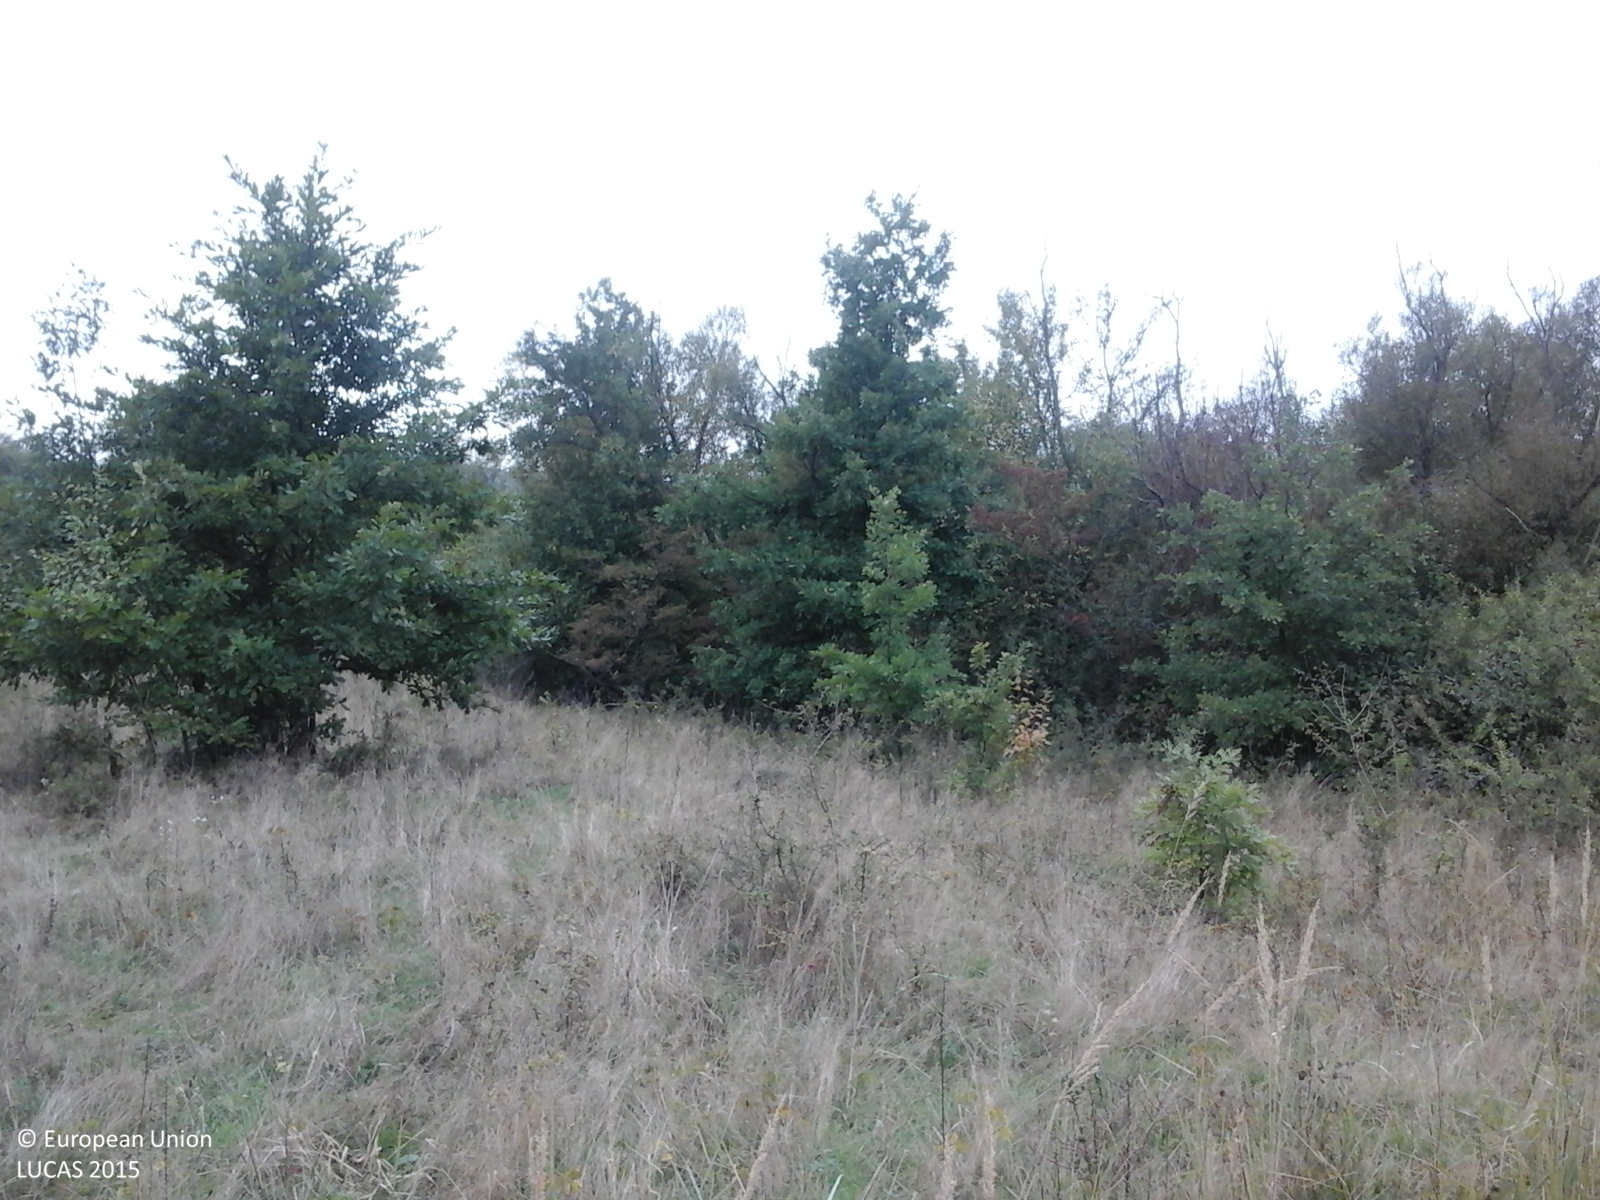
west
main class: Grassland
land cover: Spontaneously vegetated surfaces
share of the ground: > 75 %
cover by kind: herbaceous plants 100 %
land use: Fallow land
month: September
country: RO
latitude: 45.9552
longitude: 22.2369
